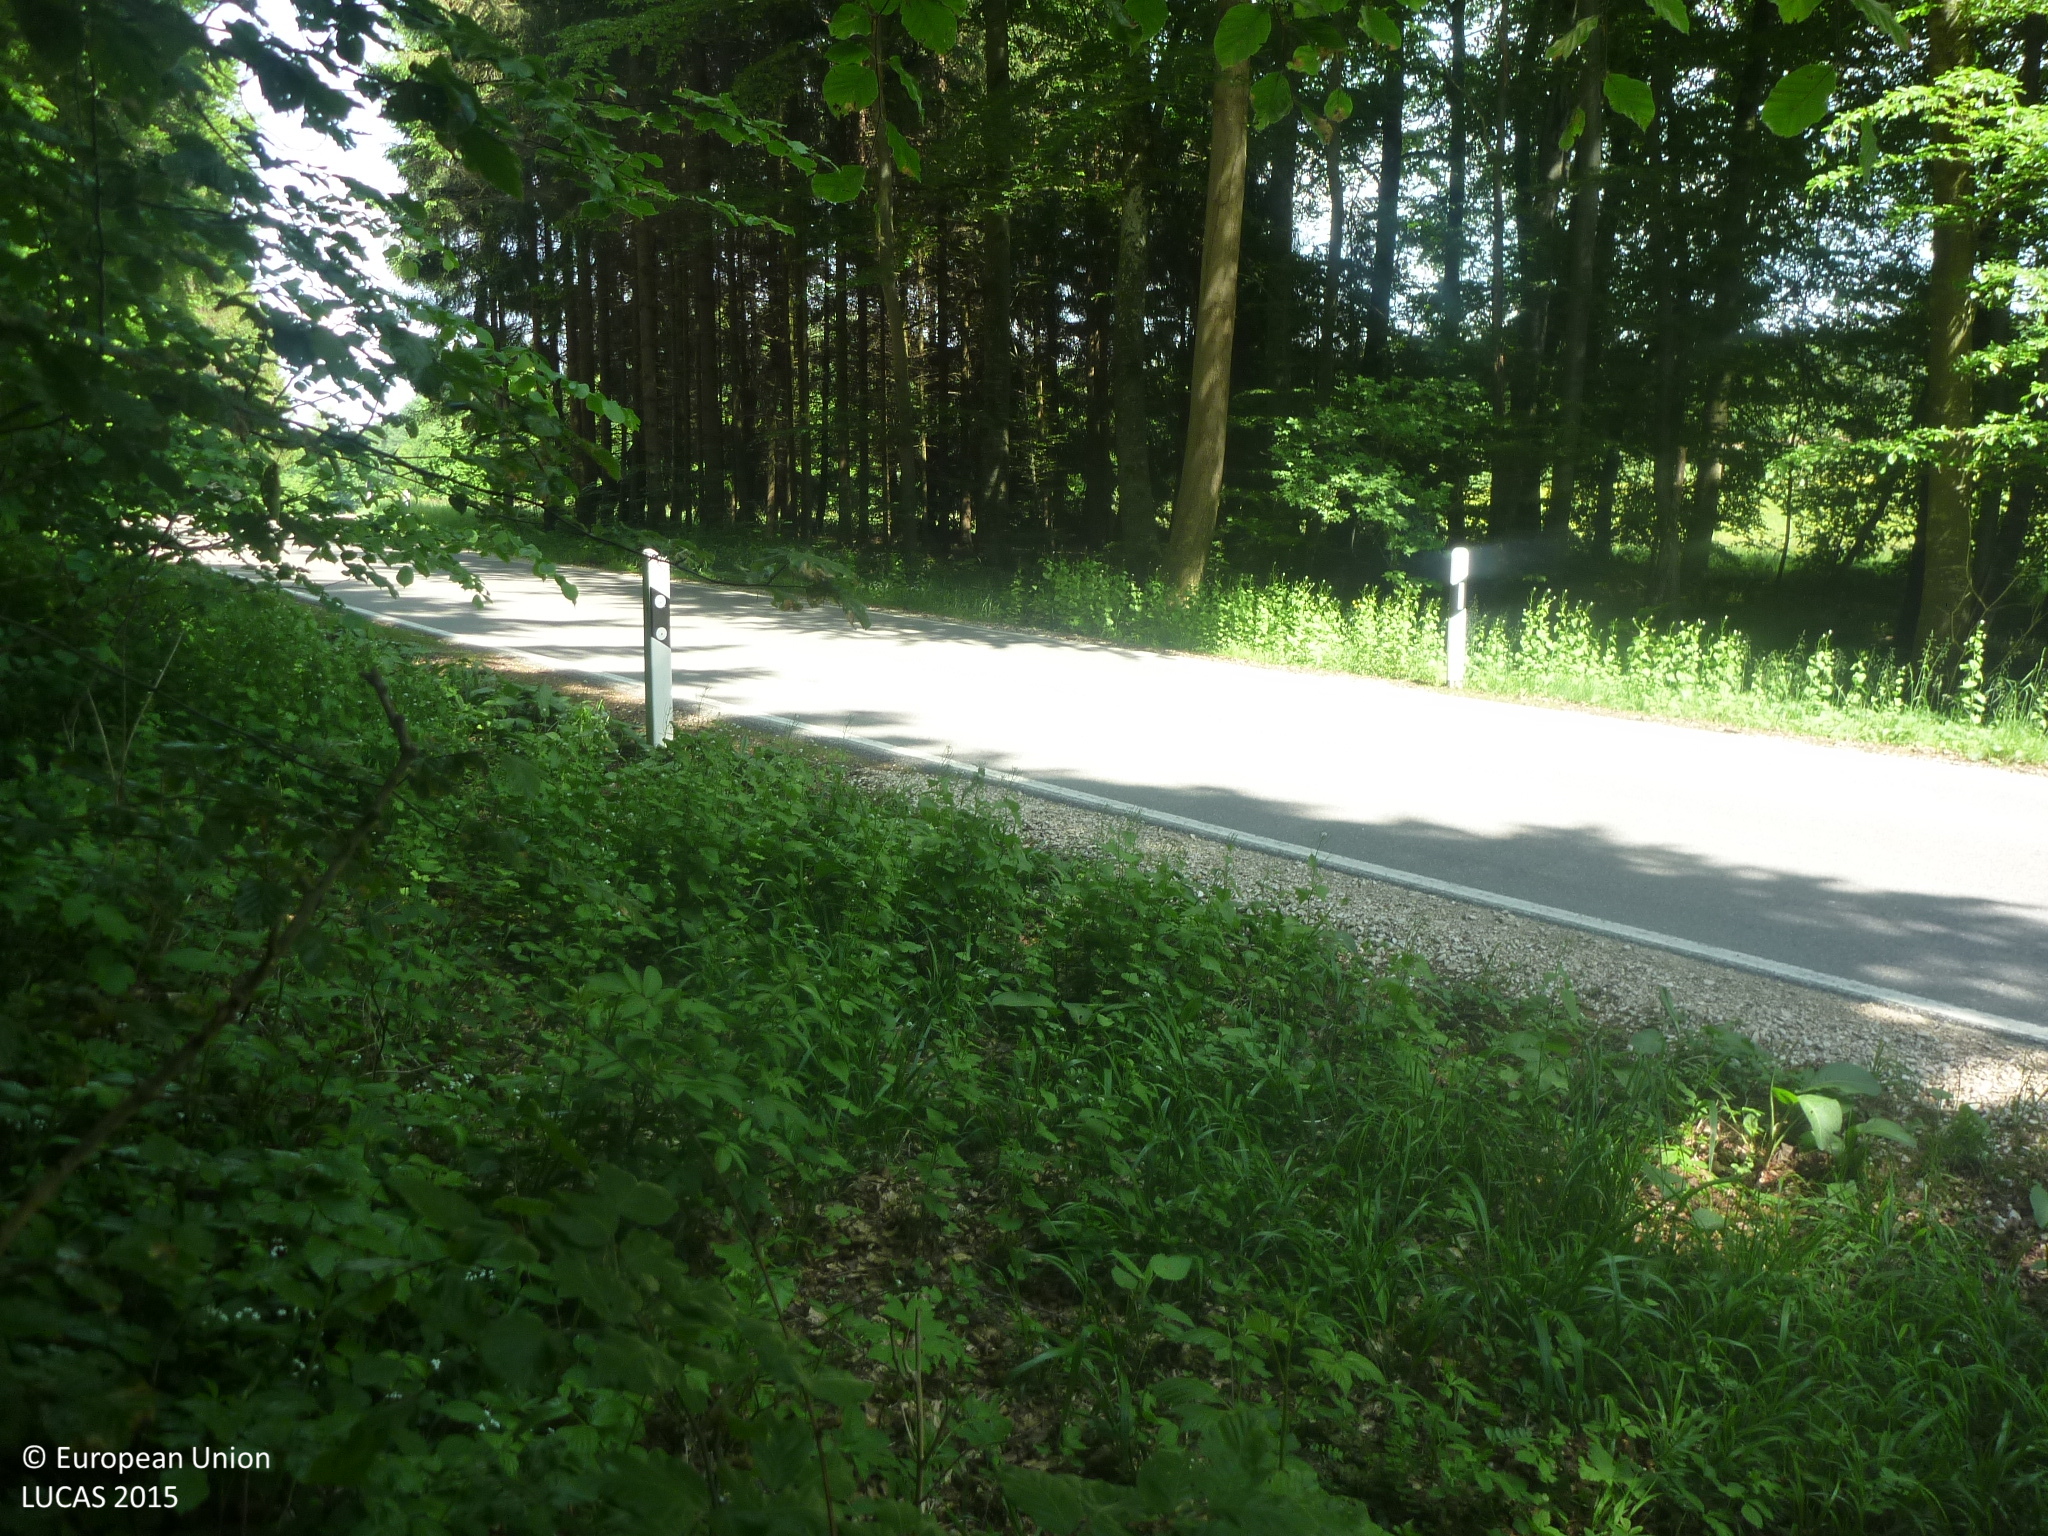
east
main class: Woodland
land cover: Broadleaved woodland
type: mesophytic deciduous forest
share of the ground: > 75 %
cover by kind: broadleaved forest trees 100 %
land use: Forestry
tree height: > 5 m
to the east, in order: Broadleaved woodland; Spontaneously vegetated surfaces; Paved roads, cycling and walking lanes; Grass margins; Broadleaved woodland; Grassland without tree/shrub cover; Paved roads, cycling and walking lanes; Fences; Grassland without tree/shrub cover; Fences; Grass margins; Tracks; Grassland without tree/shrub cover
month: May
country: DE
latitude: 48.4736
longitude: 9.3646
